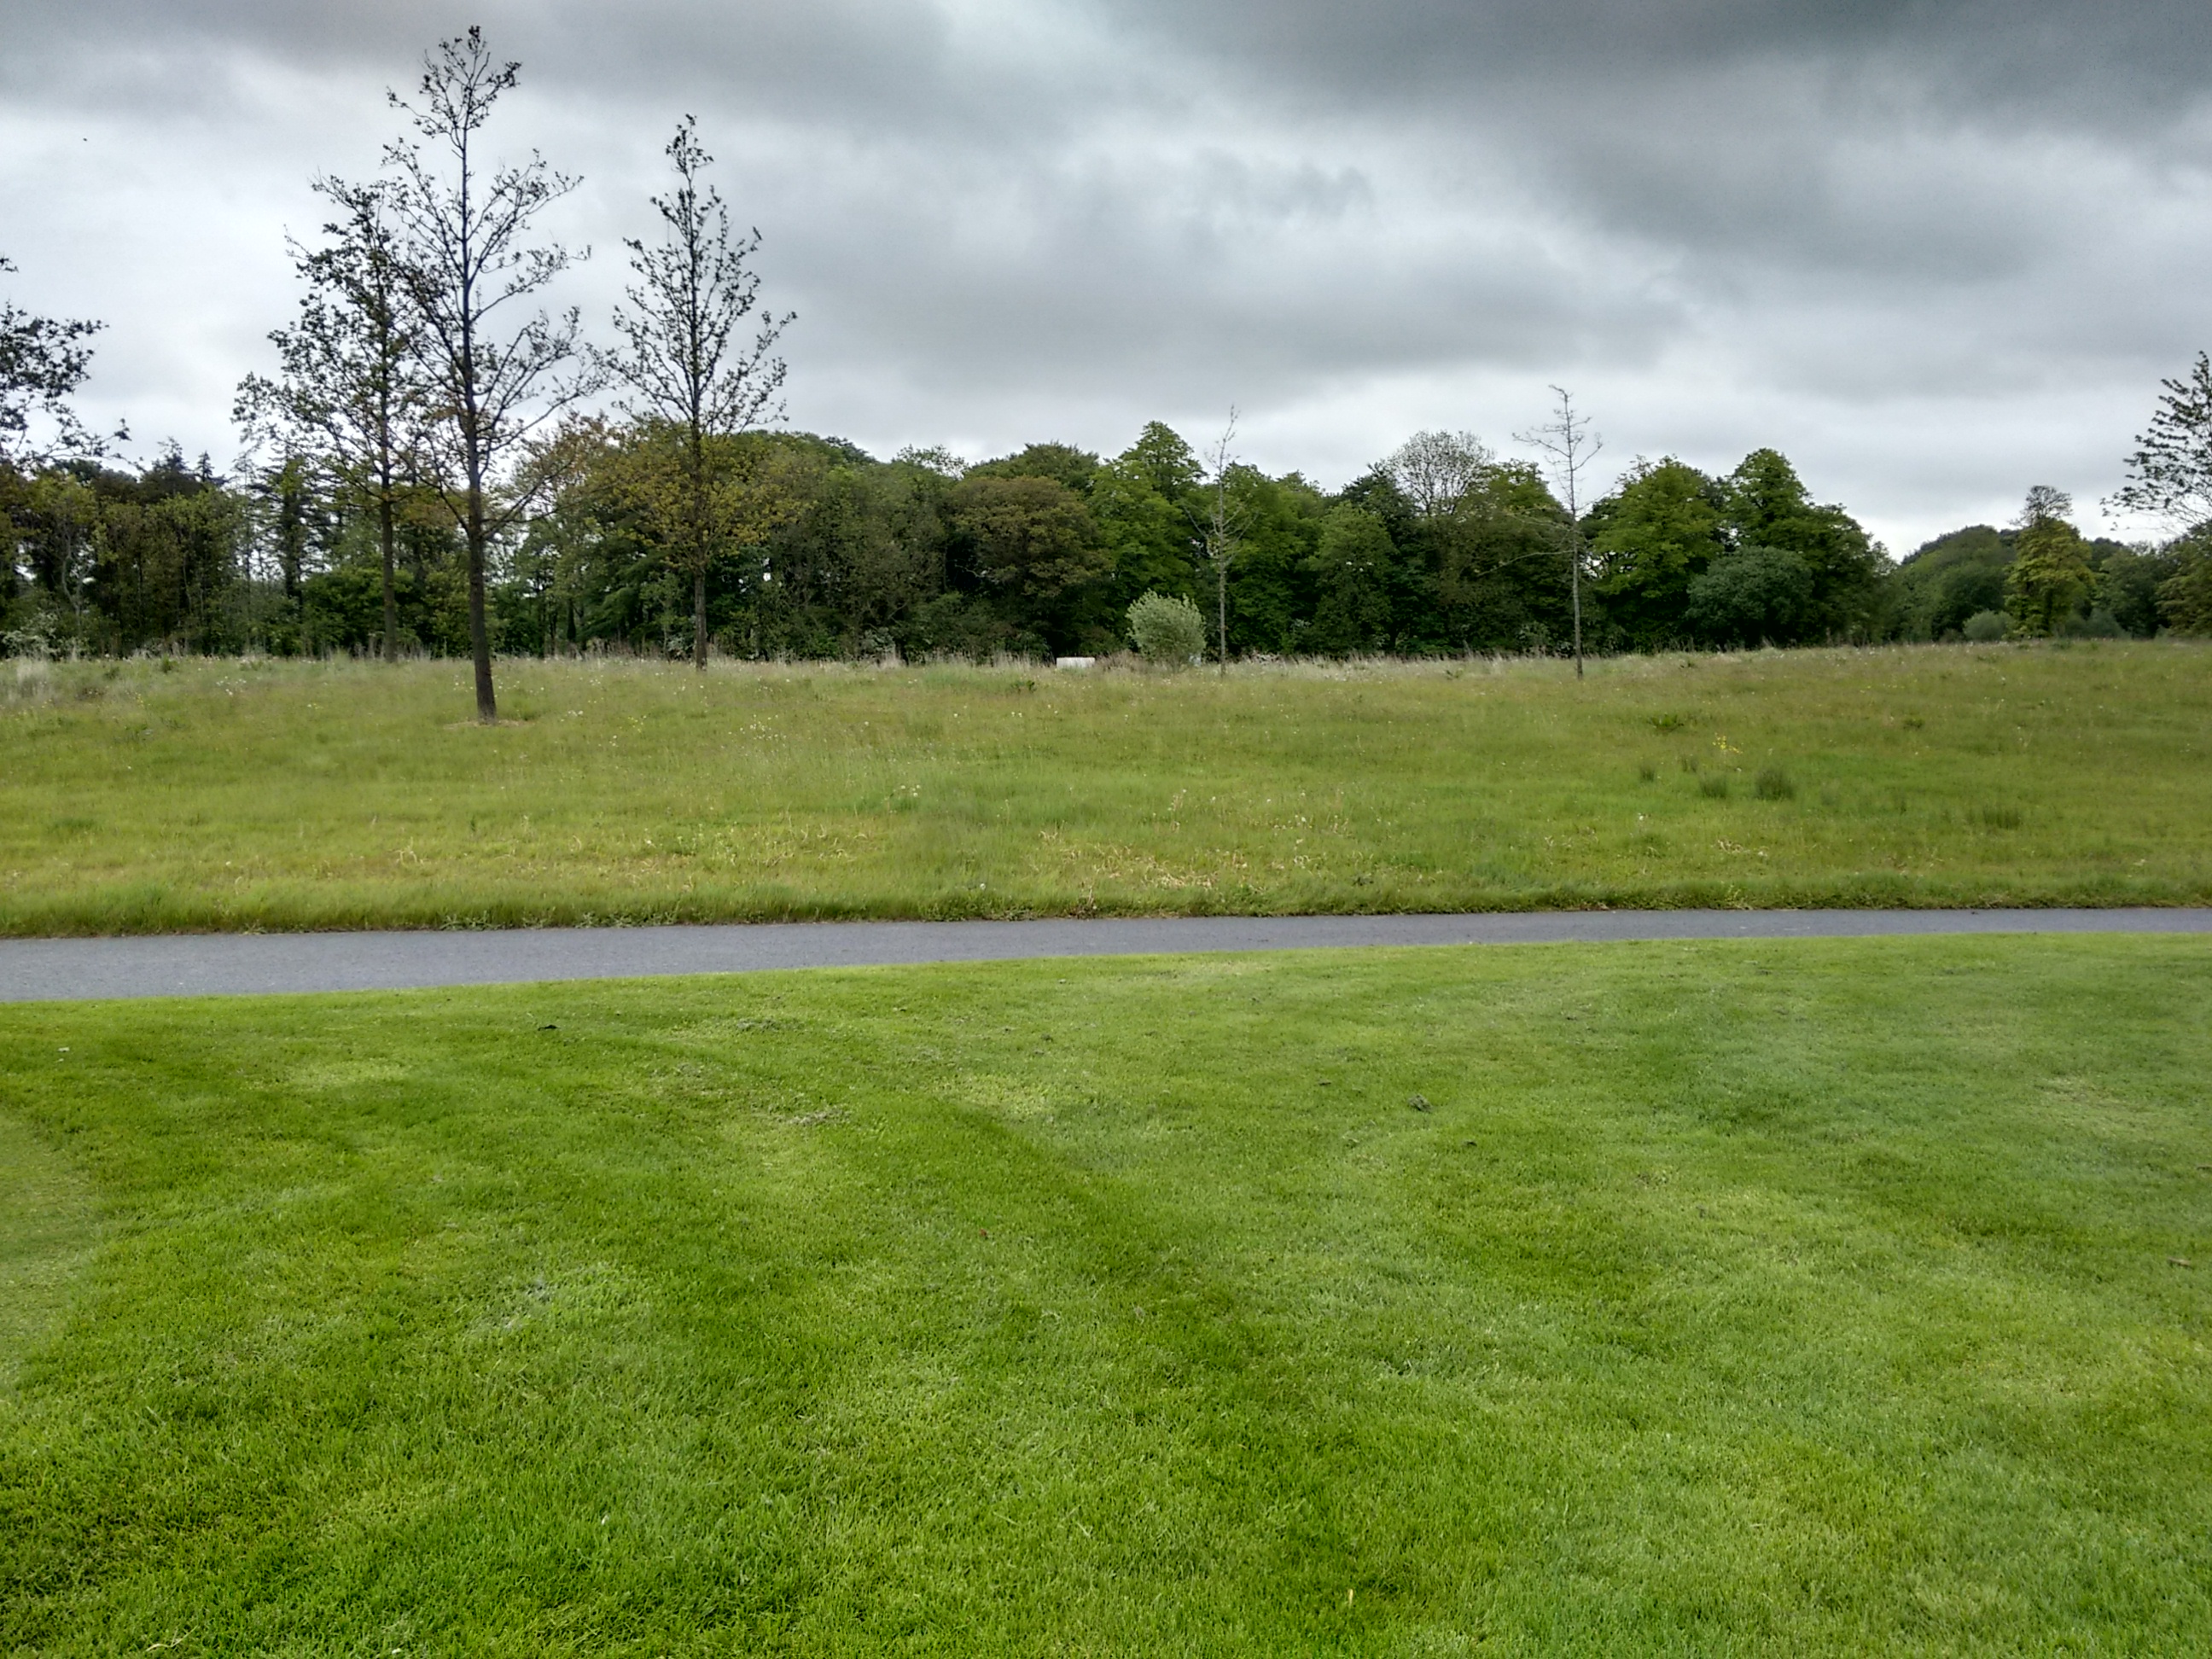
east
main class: Grassland
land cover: Grassland without tree/shrub cover
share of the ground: > 75 %
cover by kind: herbaceous plants 100 %
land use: Sport
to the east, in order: Grassland without tree/shrub cover; Tracks; Grassland with sparse tree/shrub cover; Broadleaved woodland; Paved roads, cycling and walking lanes; Grassland without tree/shrub cover
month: May
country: IE
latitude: 53.5327
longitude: -6.5892
